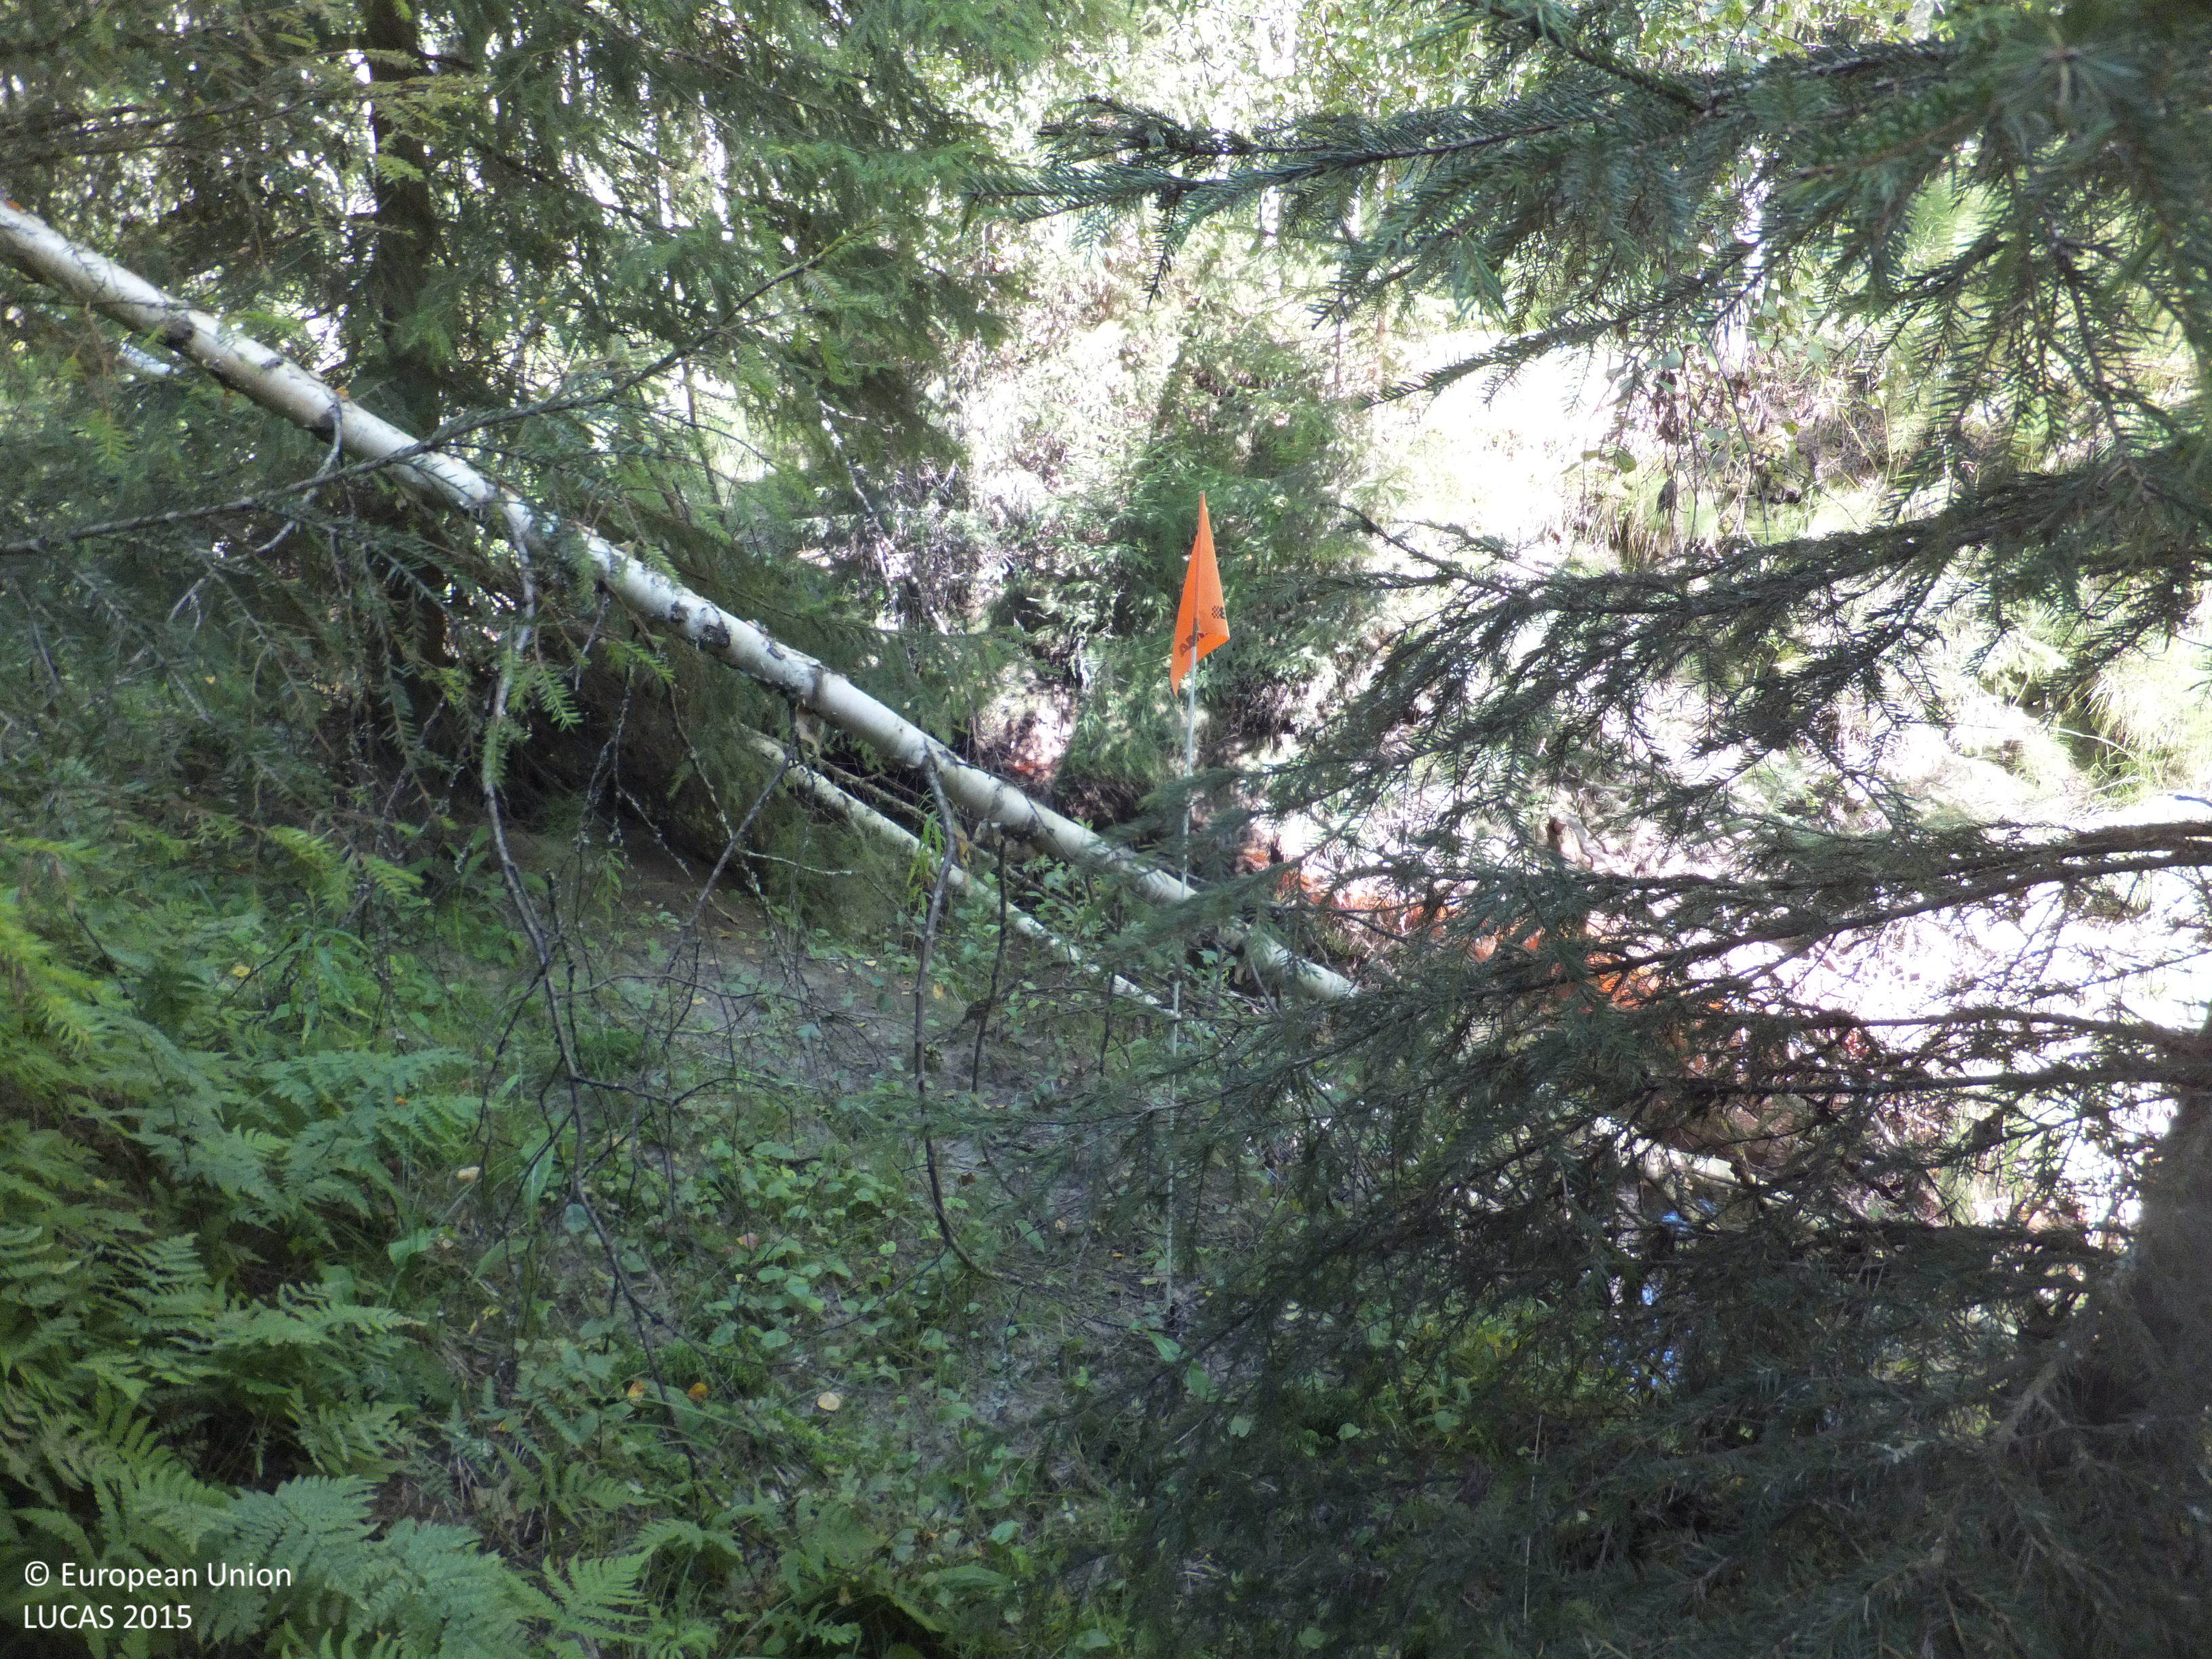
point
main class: Woodland
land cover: Spruce dominated mixed woodland
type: boreal forest
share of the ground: > 75 %
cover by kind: coniferous forest trees 40 %, broadleaved forest trees 40 %, herbaceous plants 10 %, lichens and mosses 5 %, unconsolidated bare surface 5 %
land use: Forestry
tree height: > 5 m
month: August
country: FI
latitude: 63.1138
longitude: 23.3631
